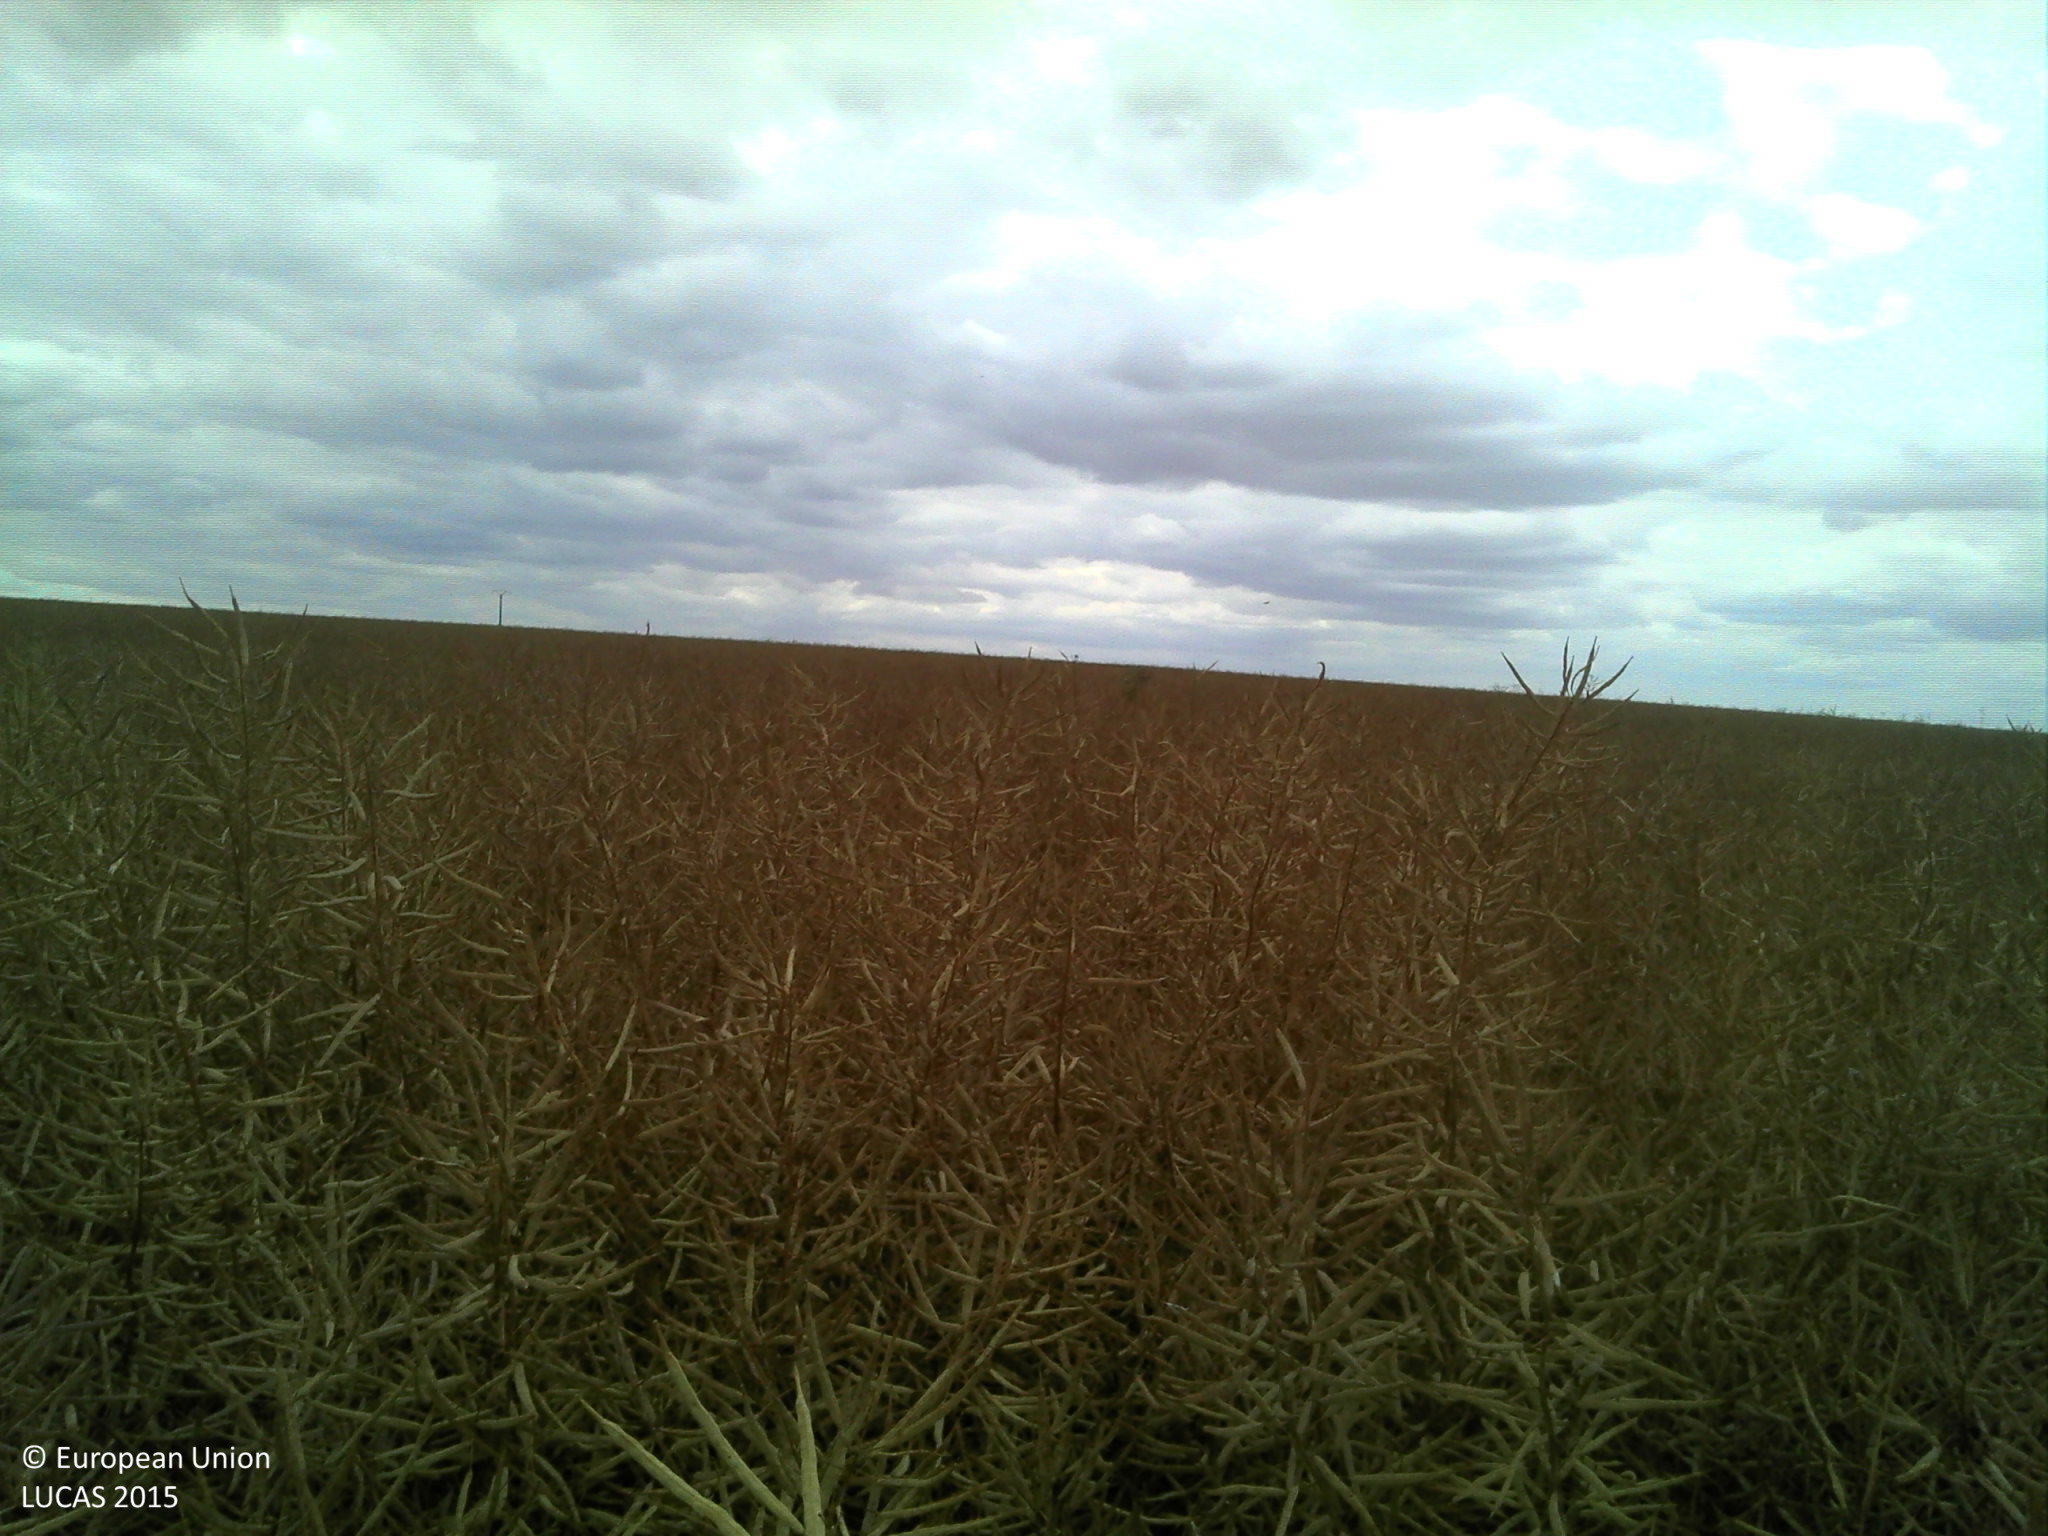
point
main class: Cropland
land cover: Rape and turnip rape
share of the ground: > 75 %
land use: Agriculture (excluding fallow land and kitchen gardens)
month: July
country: FR
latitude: 48.3504
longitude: 3.3952
